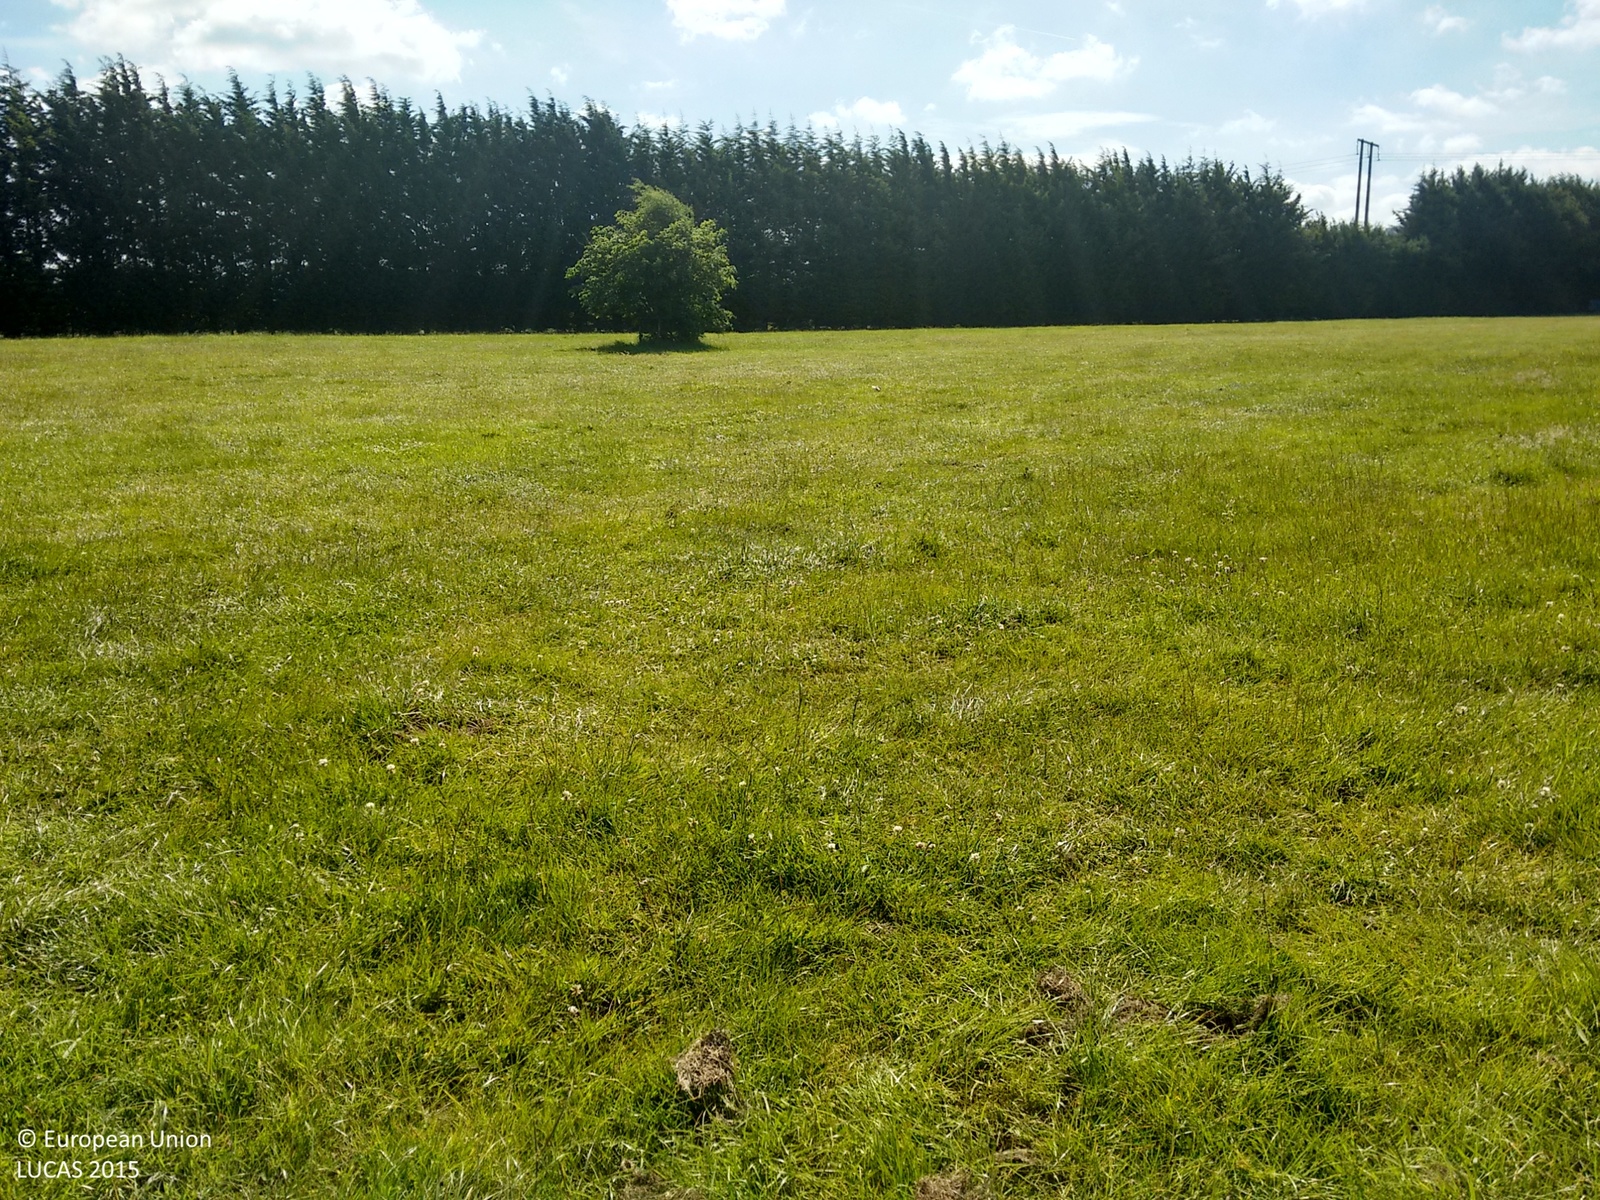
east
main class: Grassland
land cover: Grassland without tree/shrub cover
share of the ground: > 75 %
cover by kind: herbaceous plants 100 %
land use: Sport
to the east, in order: Grassland without tree/shrub cover; Fences; Lines of trees; Grass margins; Grassland with sparse tree/shrub cover; Grassland without tree/shrub cover; Grassland with sparse tree/shrub cover; Grassland without tree/shrub cover; Electric lines
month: June
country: GB
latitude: 52.0862
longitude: -2.0703
